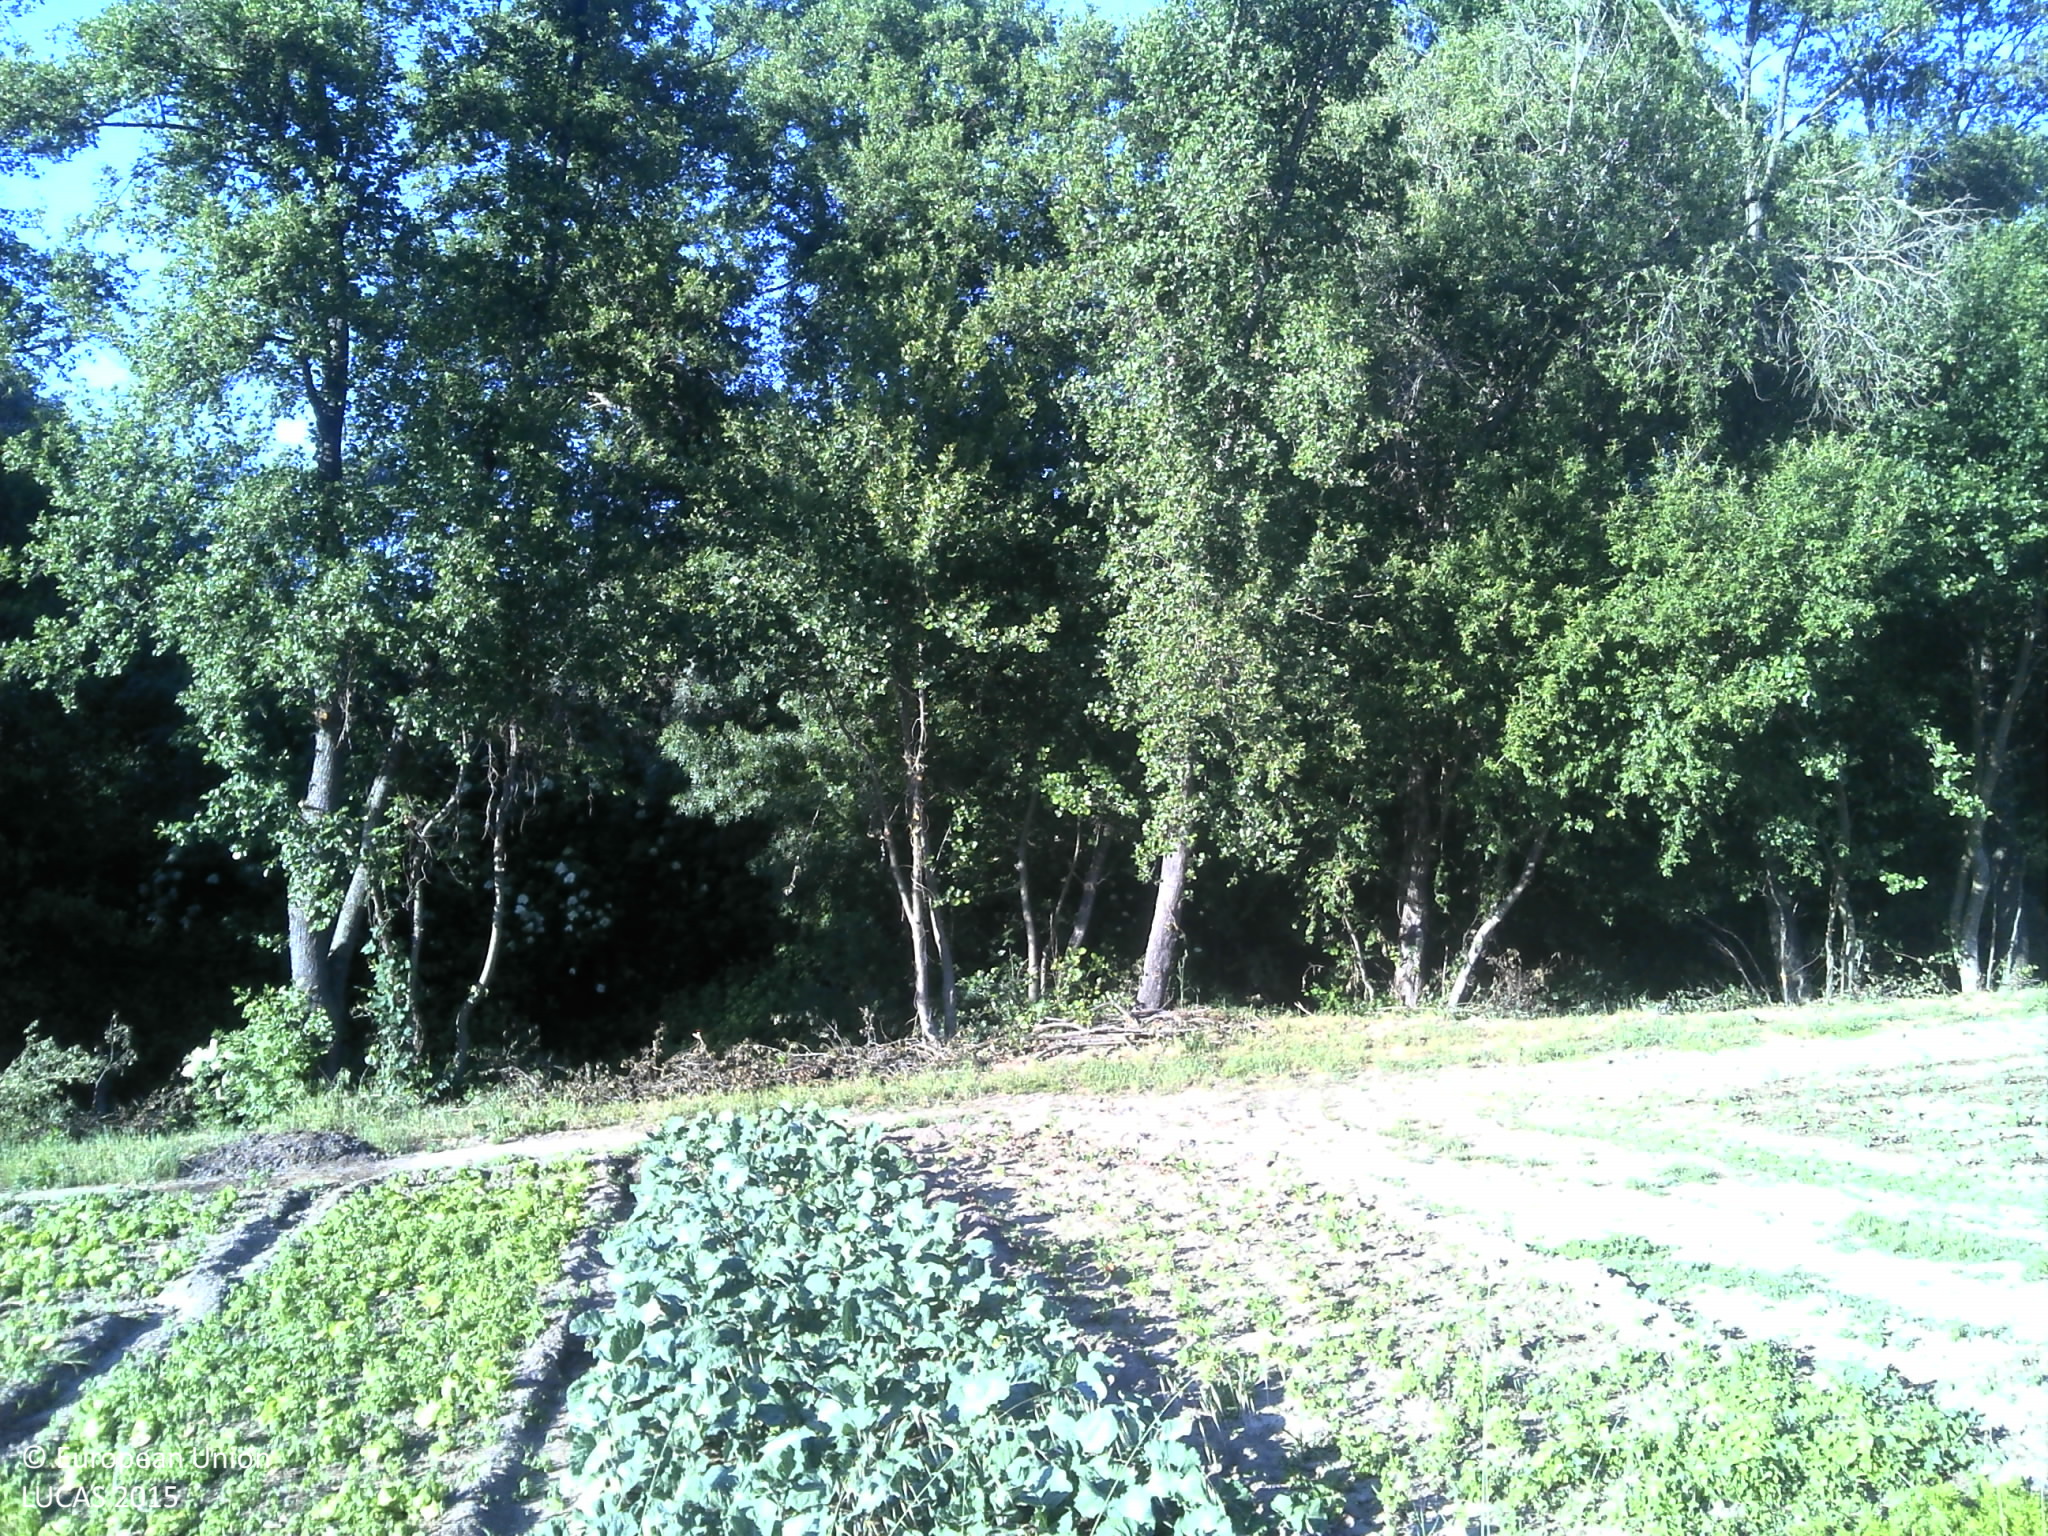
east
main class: Cropland
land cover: Maize
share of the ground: 10 - 25 %
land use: Agriculture (excluding fallow land and kitchen gardens)
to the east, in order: Maize; Dry stone walls; Ditches and canals; Tracks; Other fresh vegetables; Broadleaved woodland; Inland fresh running water; Broadleaved woodland; Shrubland without tree cover; Broadleaved woodland; Tracks; Shrubland without tree cover
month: May
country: PT
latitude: 40.6162
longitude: -7.3065
